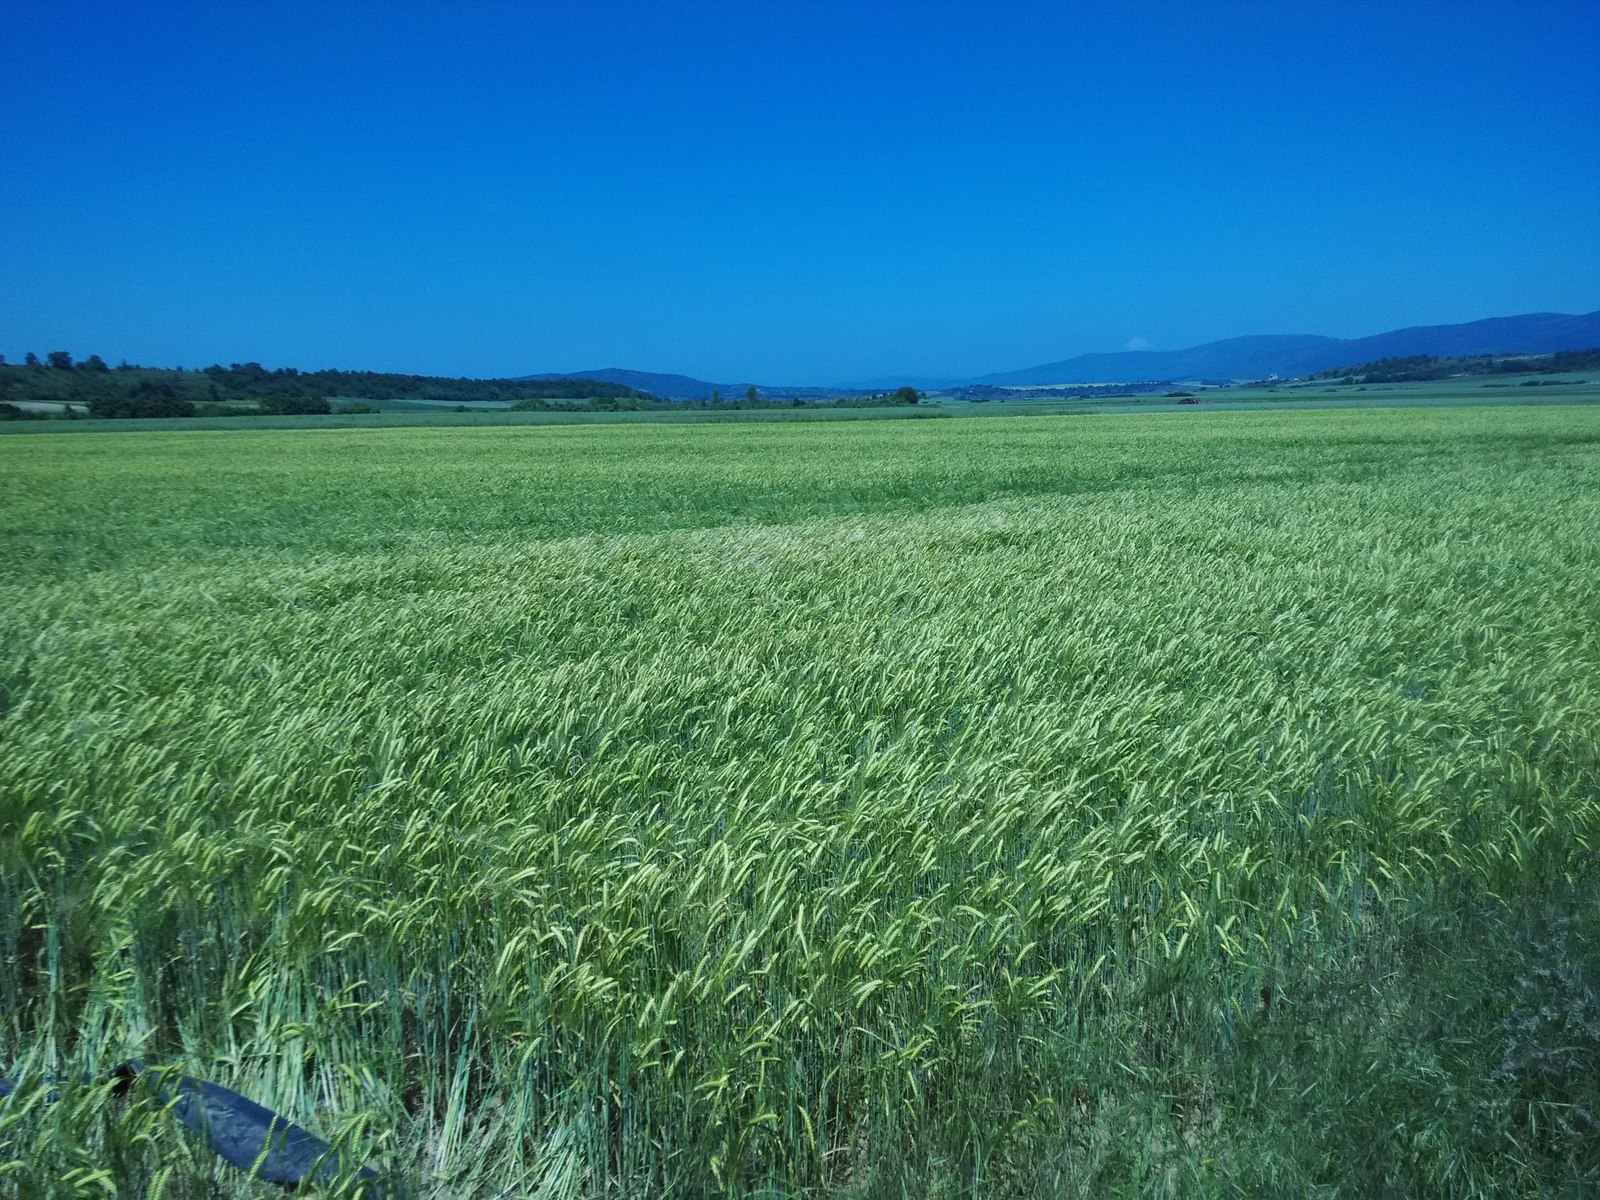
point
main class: Cropland
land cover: Barley
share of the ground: > 75 %
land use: Agriculture (excluding fallow land and kitchen gardens)
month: June
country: ES
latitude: 42.8801
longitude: -2.3518
